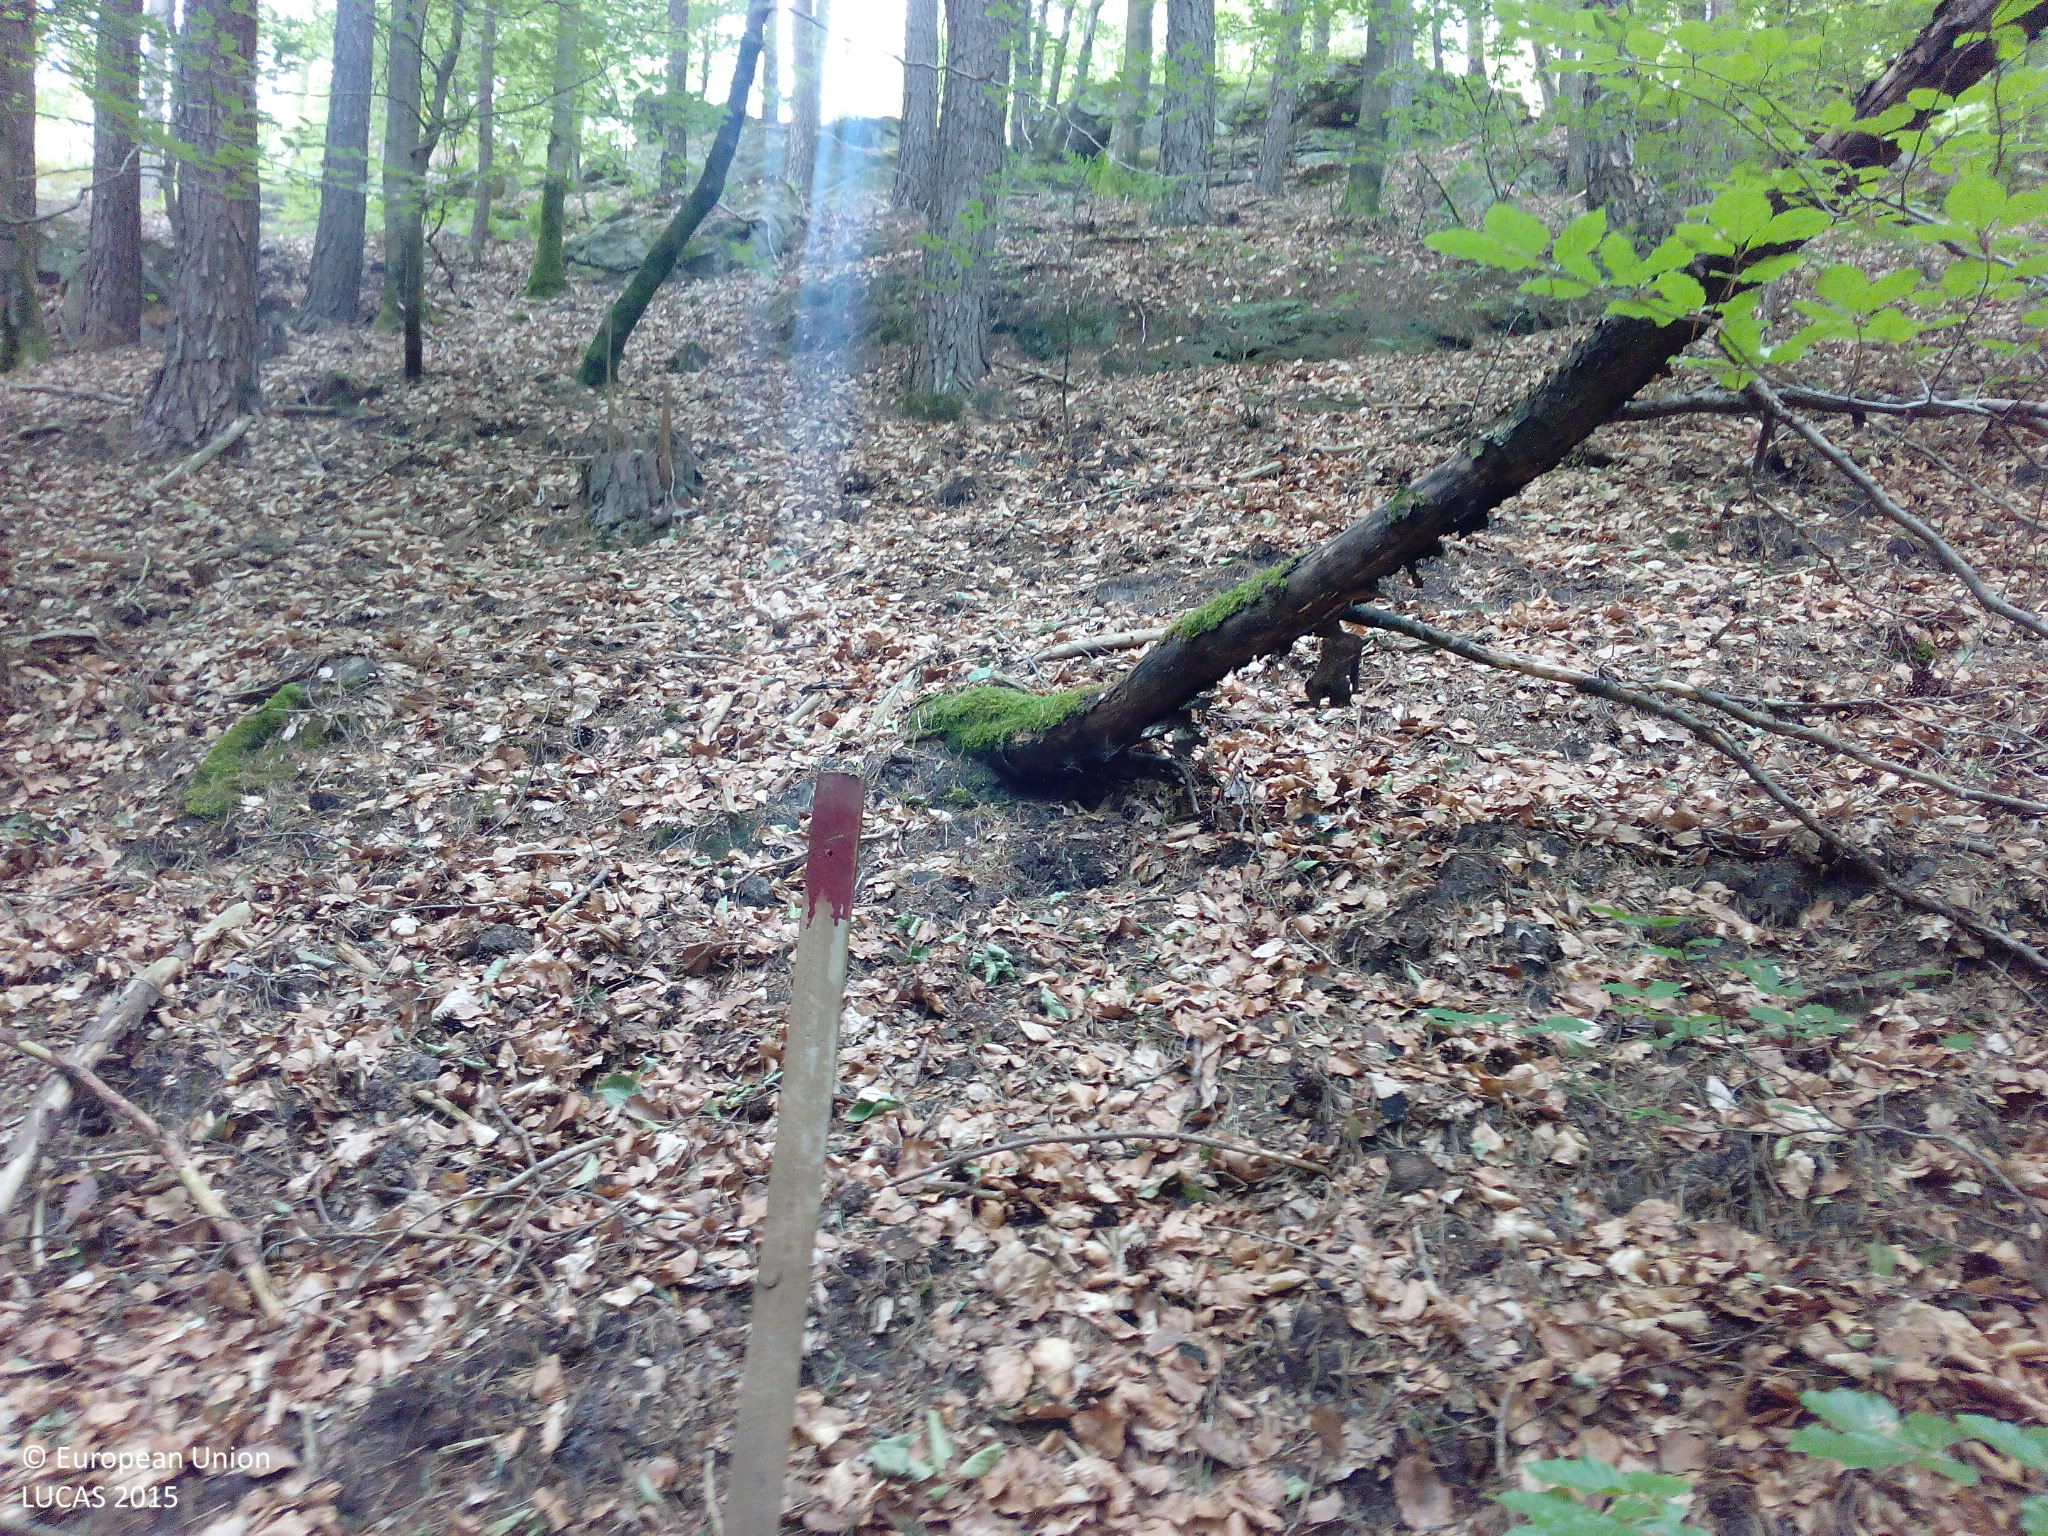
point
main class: Woodland
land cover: Pine dominated mixed woodland
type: hemiboreal forest and nemoral coniferous forest and mixed broadleaved-coniferous forest
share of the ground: > 75 %
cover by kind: broadleaved forest trees 70 %, coniferous forest trees 25 %, unconsolidated bare surface 5 %
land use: Forestry
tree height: > 5 m
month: July
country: DE
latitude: 49.0969
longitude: 7.5765
